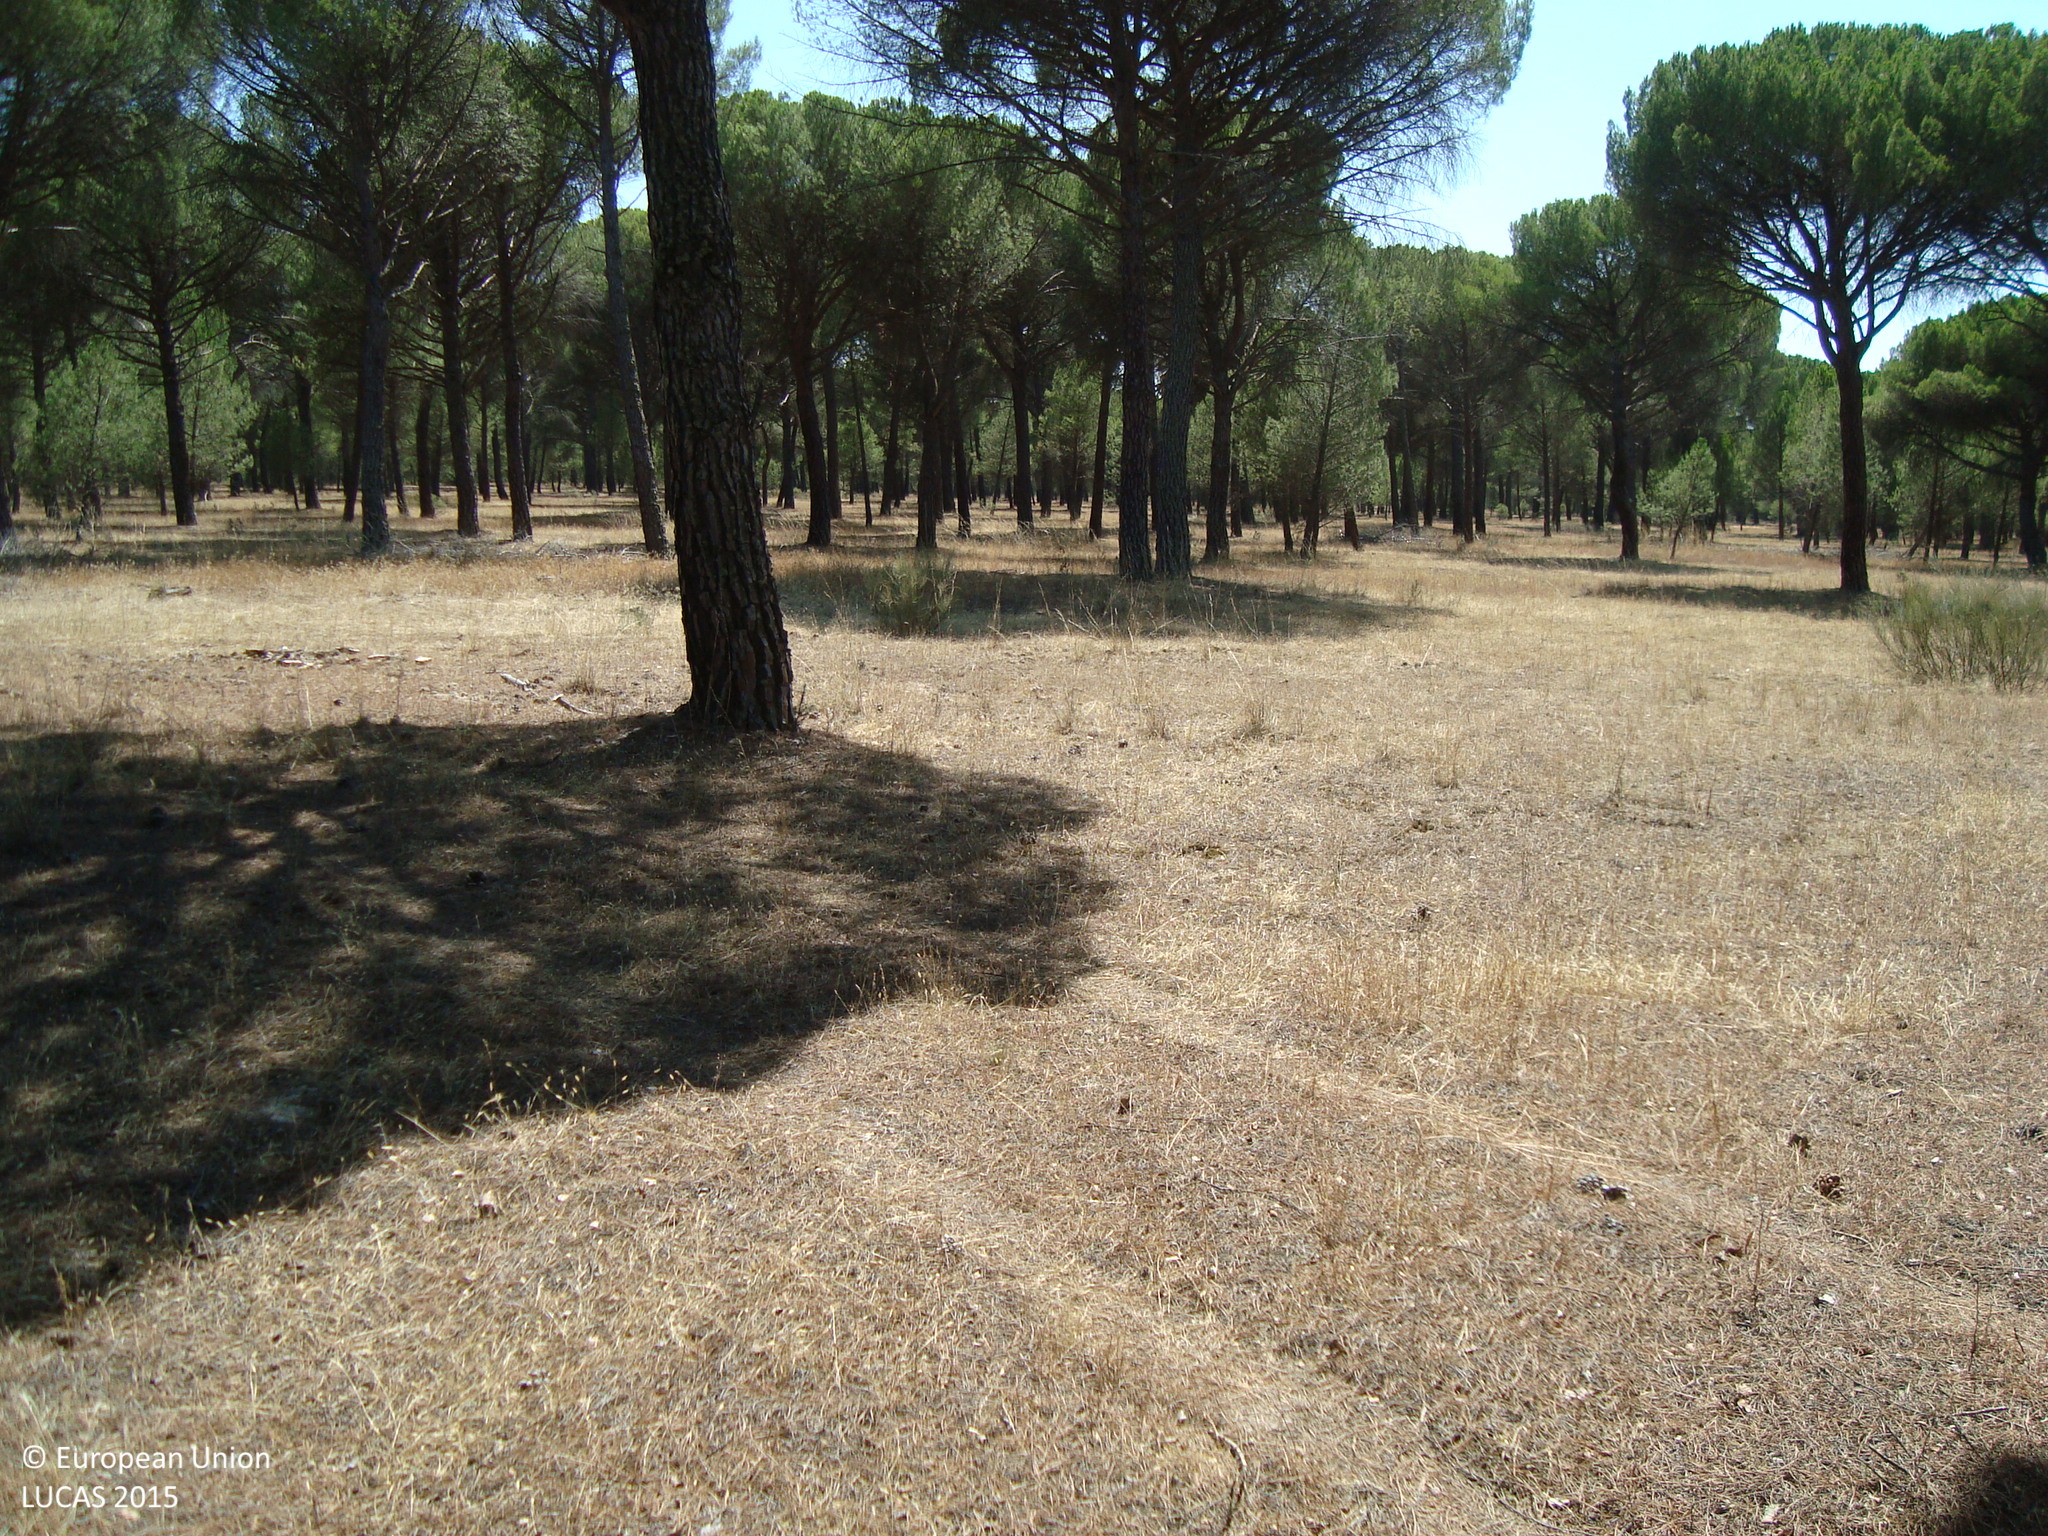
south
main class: Woodland
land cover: Pine dominated coniferous woodland
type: coniferous forest of the mediterranean region
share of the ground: 50 - 75 %
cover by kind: coniferous forest trees 60 %, herbaceous plants 30 %, shrubs 5 %, unconsolidated bare surface 5 %
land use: Forestry
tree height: > 5 m
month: August
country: ES
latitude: 41.2969
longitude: -4.5961
